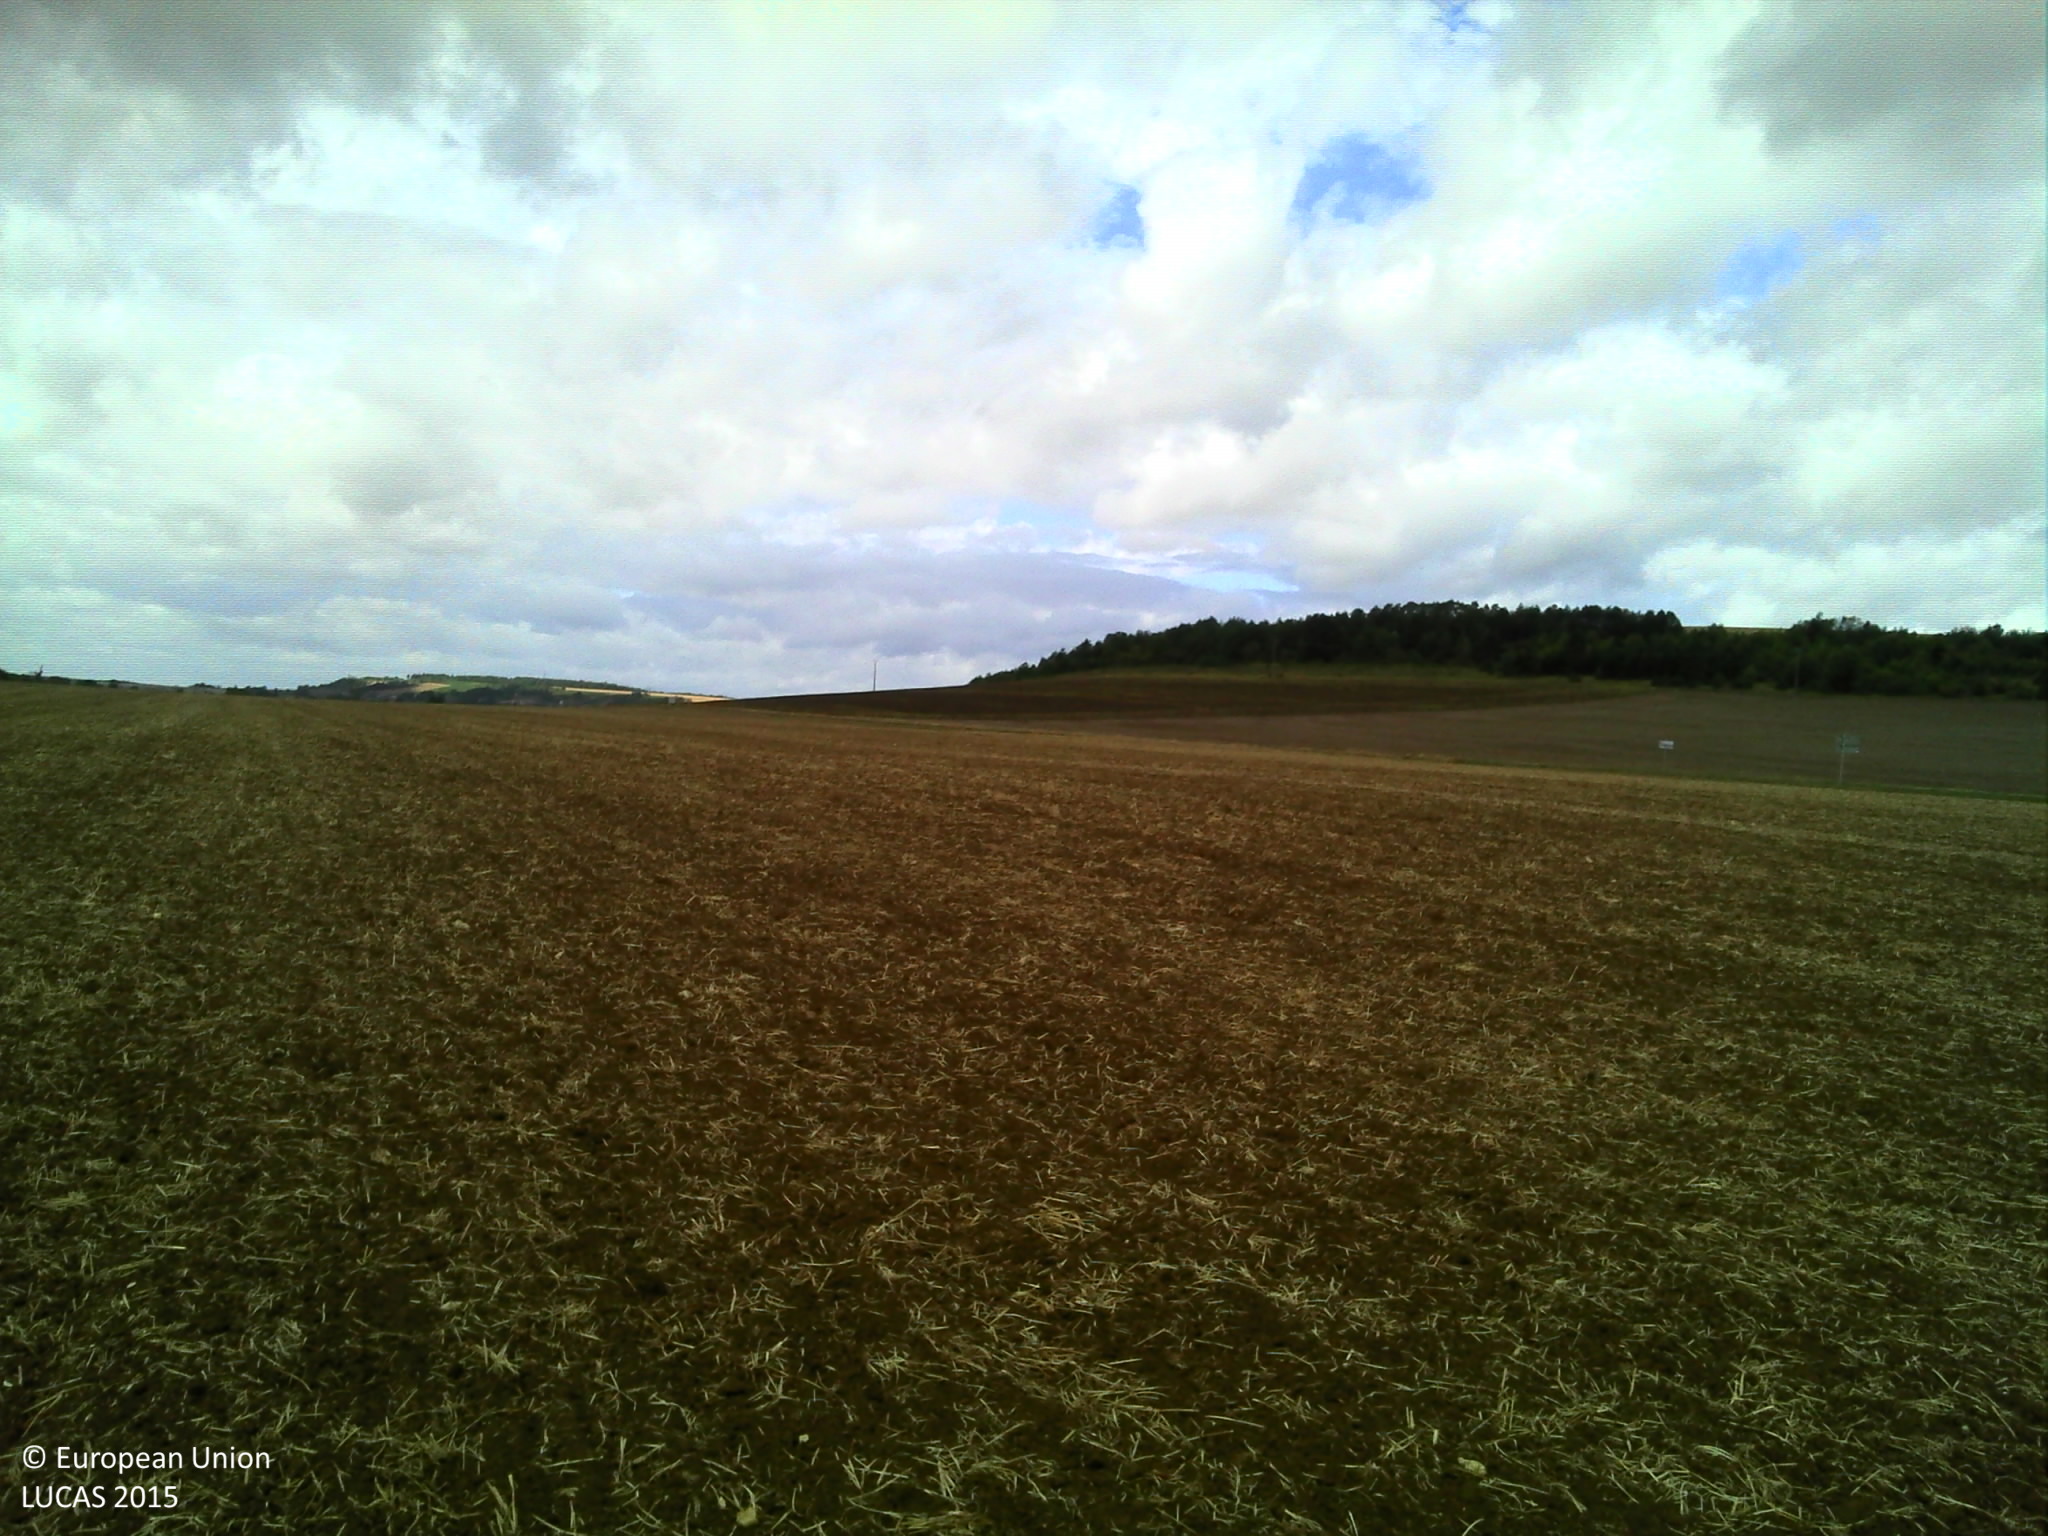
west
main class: Cropland
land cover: Barley
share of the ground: < 10 %
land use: Agriculture (excluding fallow land and kitchen gardens)
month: August
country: FR
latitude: 47.9190
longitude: 4.7666
